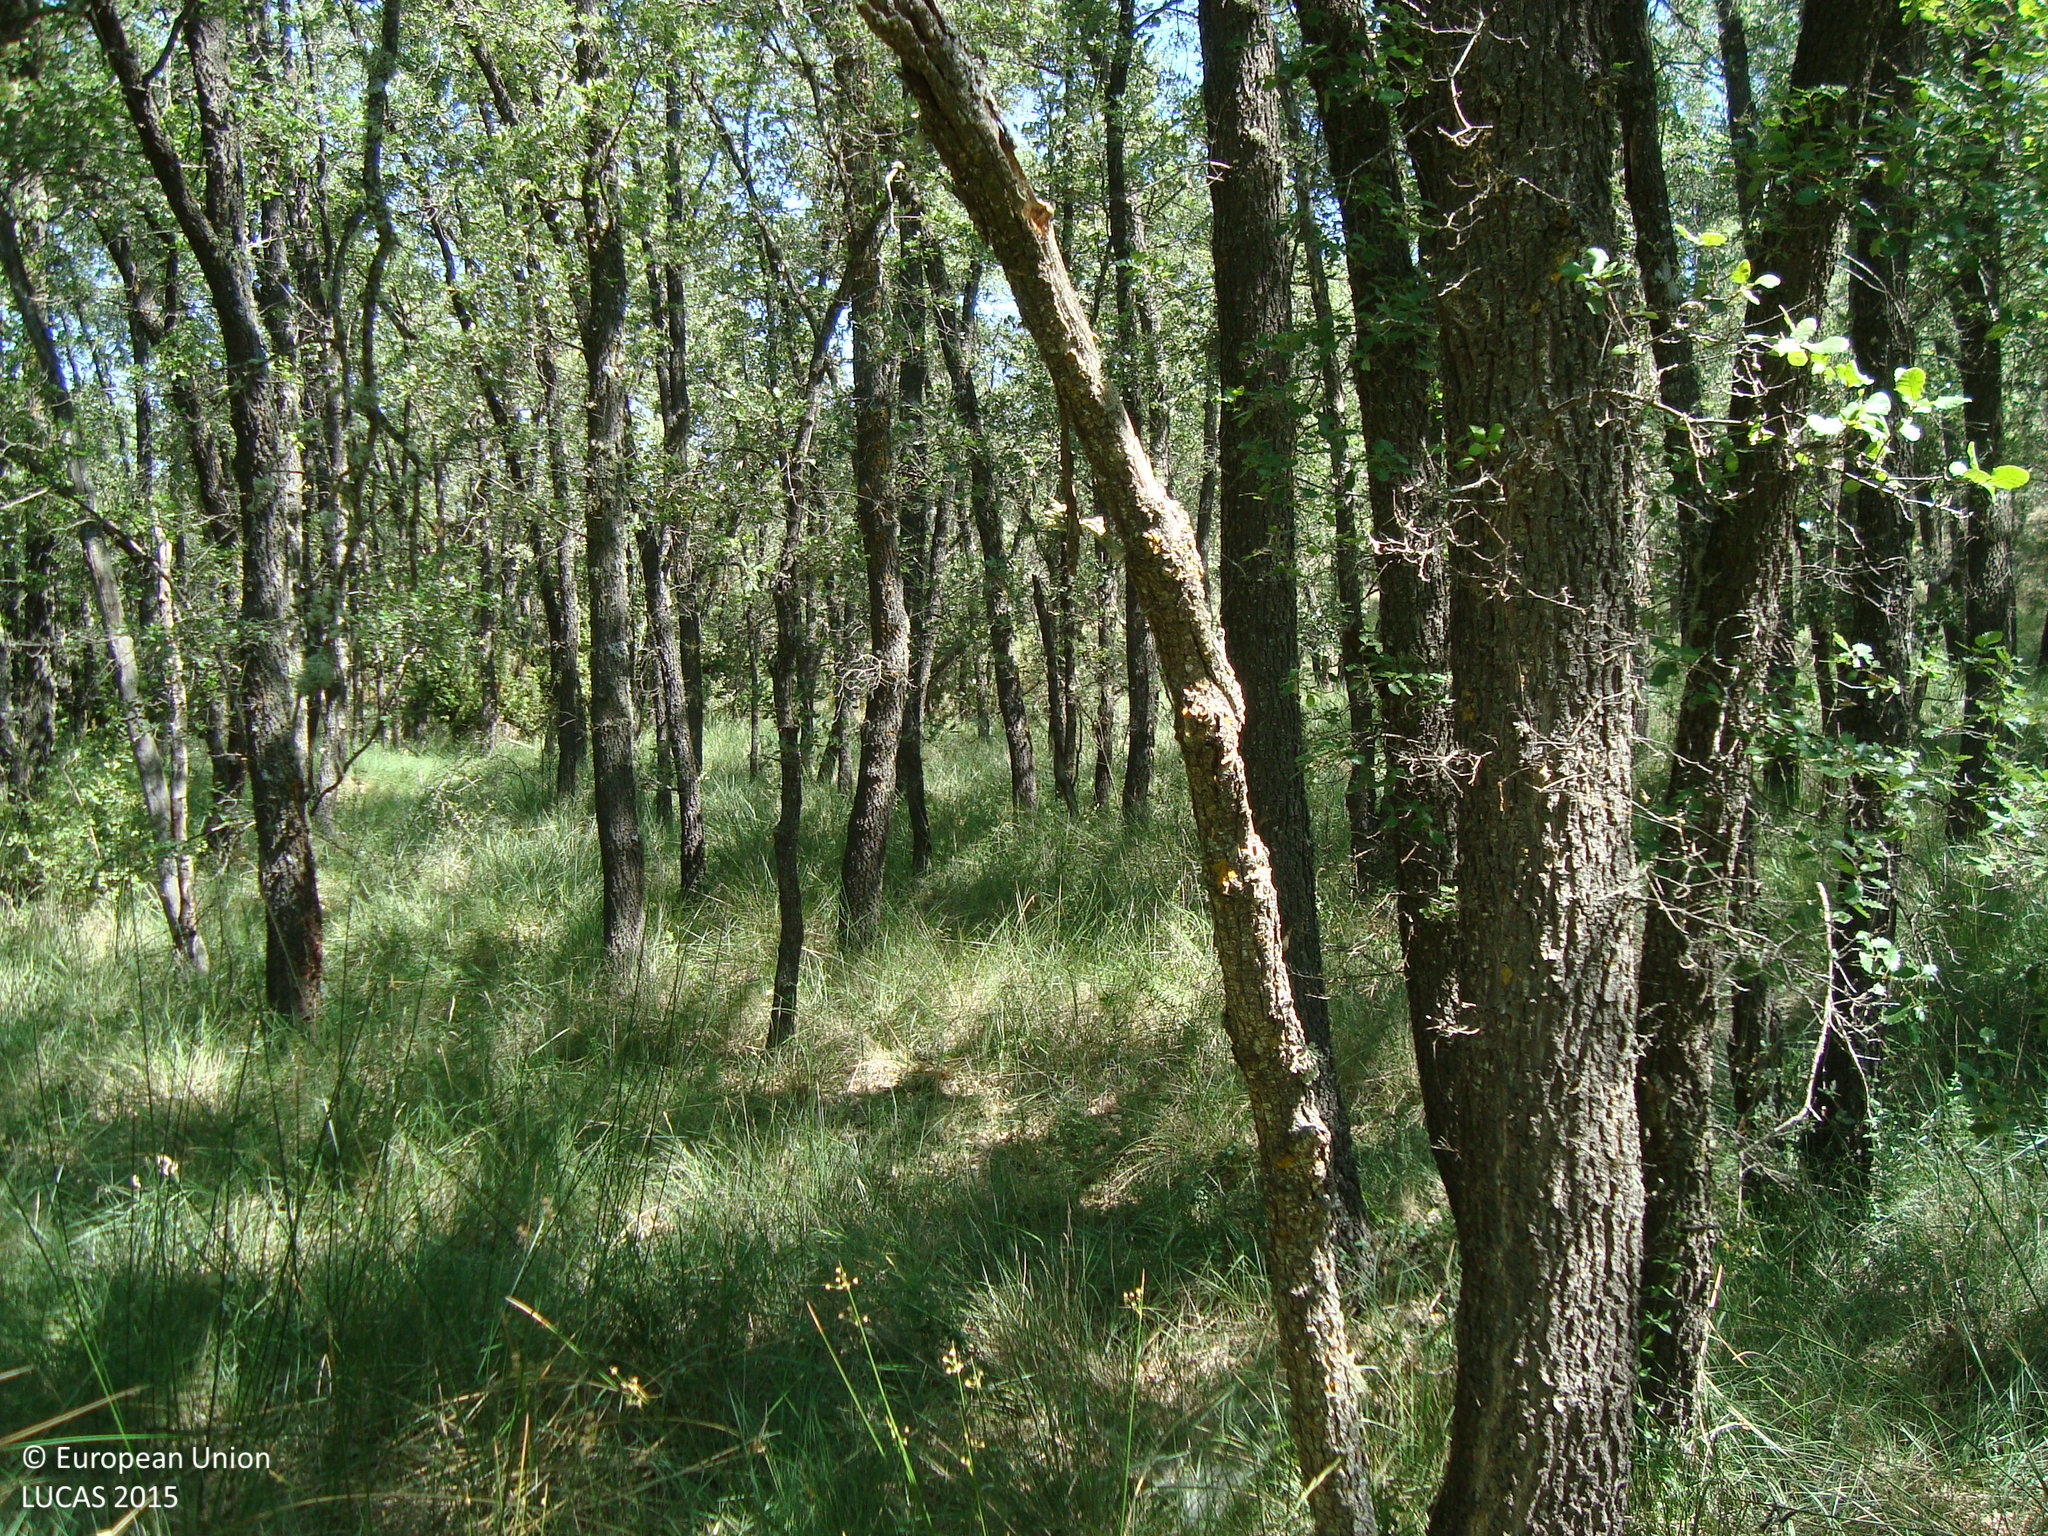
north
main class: Woodland
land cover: Broadleaved woodland
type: thermophilous deciduous forest
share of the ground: > 75 %
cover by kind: broadleaved forest trees 80 %, herbaceous plants 20 %
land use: Forestry
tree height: > 5 m
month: July
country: ES
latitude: 41.8260
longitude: -4.2341
